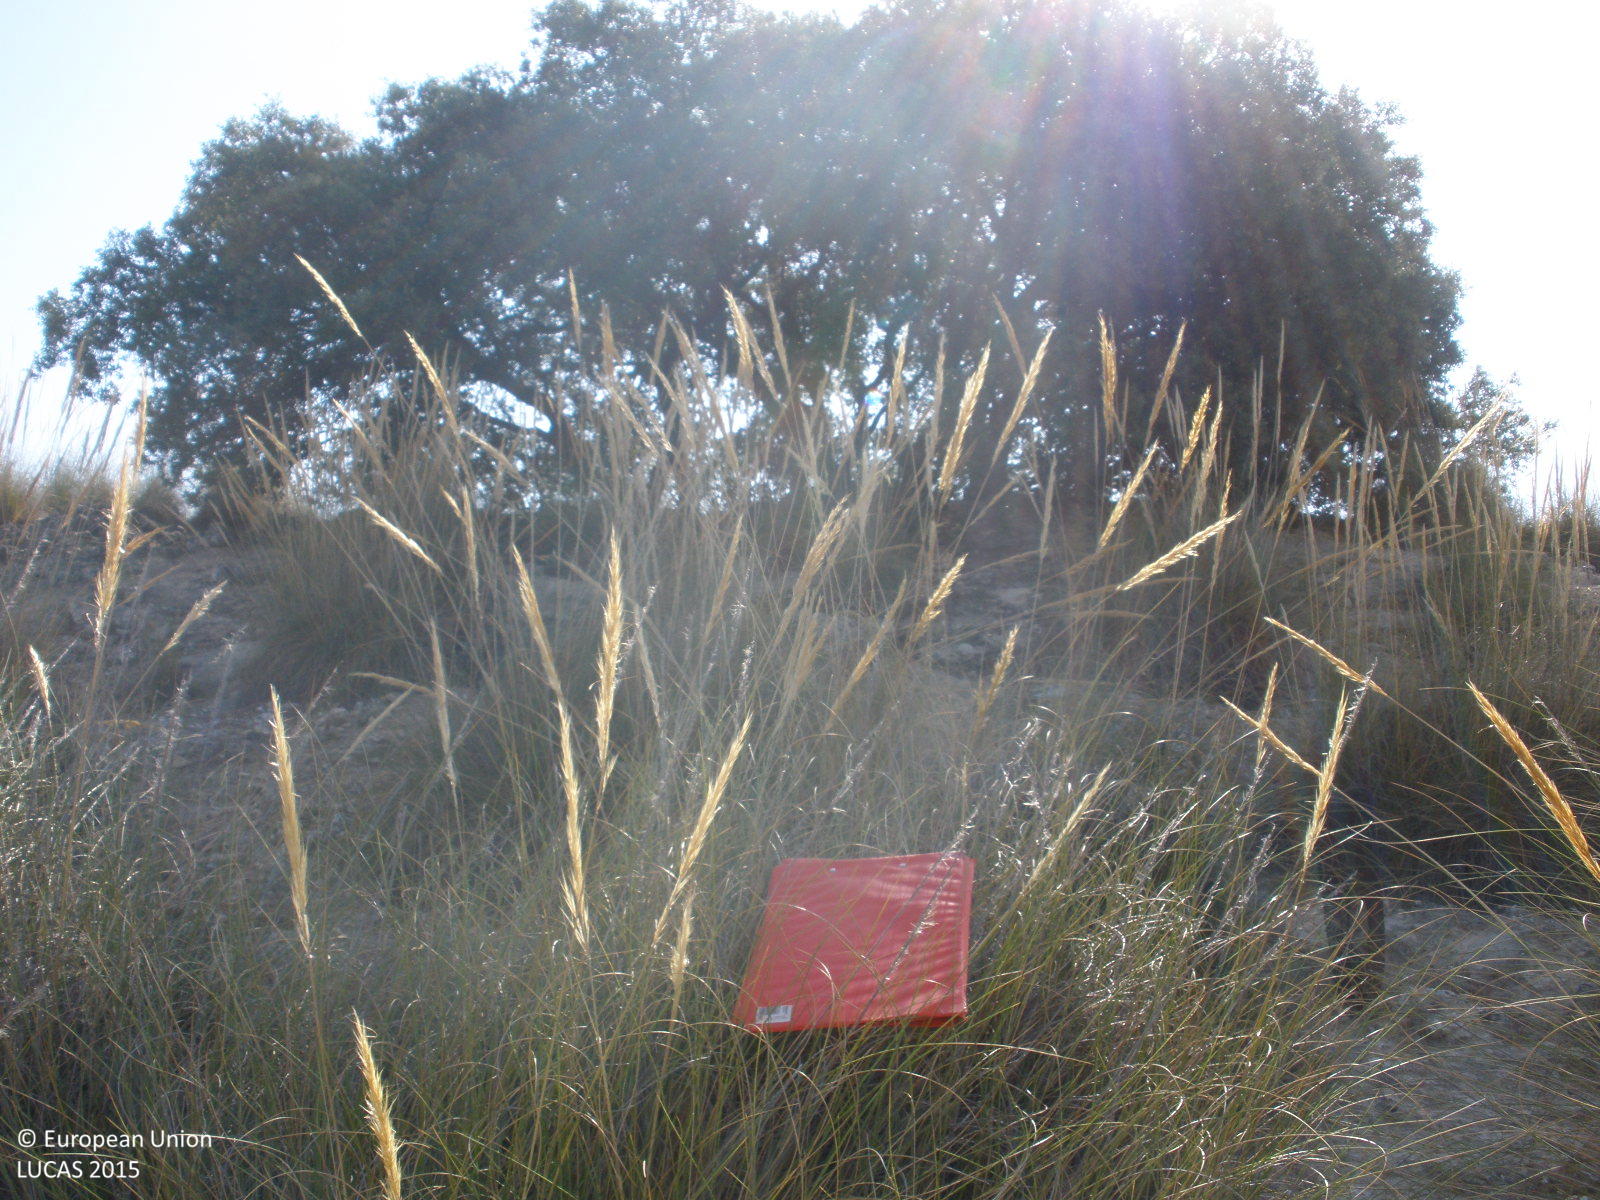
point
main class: Woodland
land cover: Broadleaved woodland
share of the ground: 25 - 50 %
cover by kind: shrubs 35 %, broadleaved forest trees 30 %, consolidated bare surface 25 %, herbaceous plants 10 %
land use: Semi-natural and natural areas not in use
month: June
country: ES
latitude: 40.1116
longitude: -3.2740
